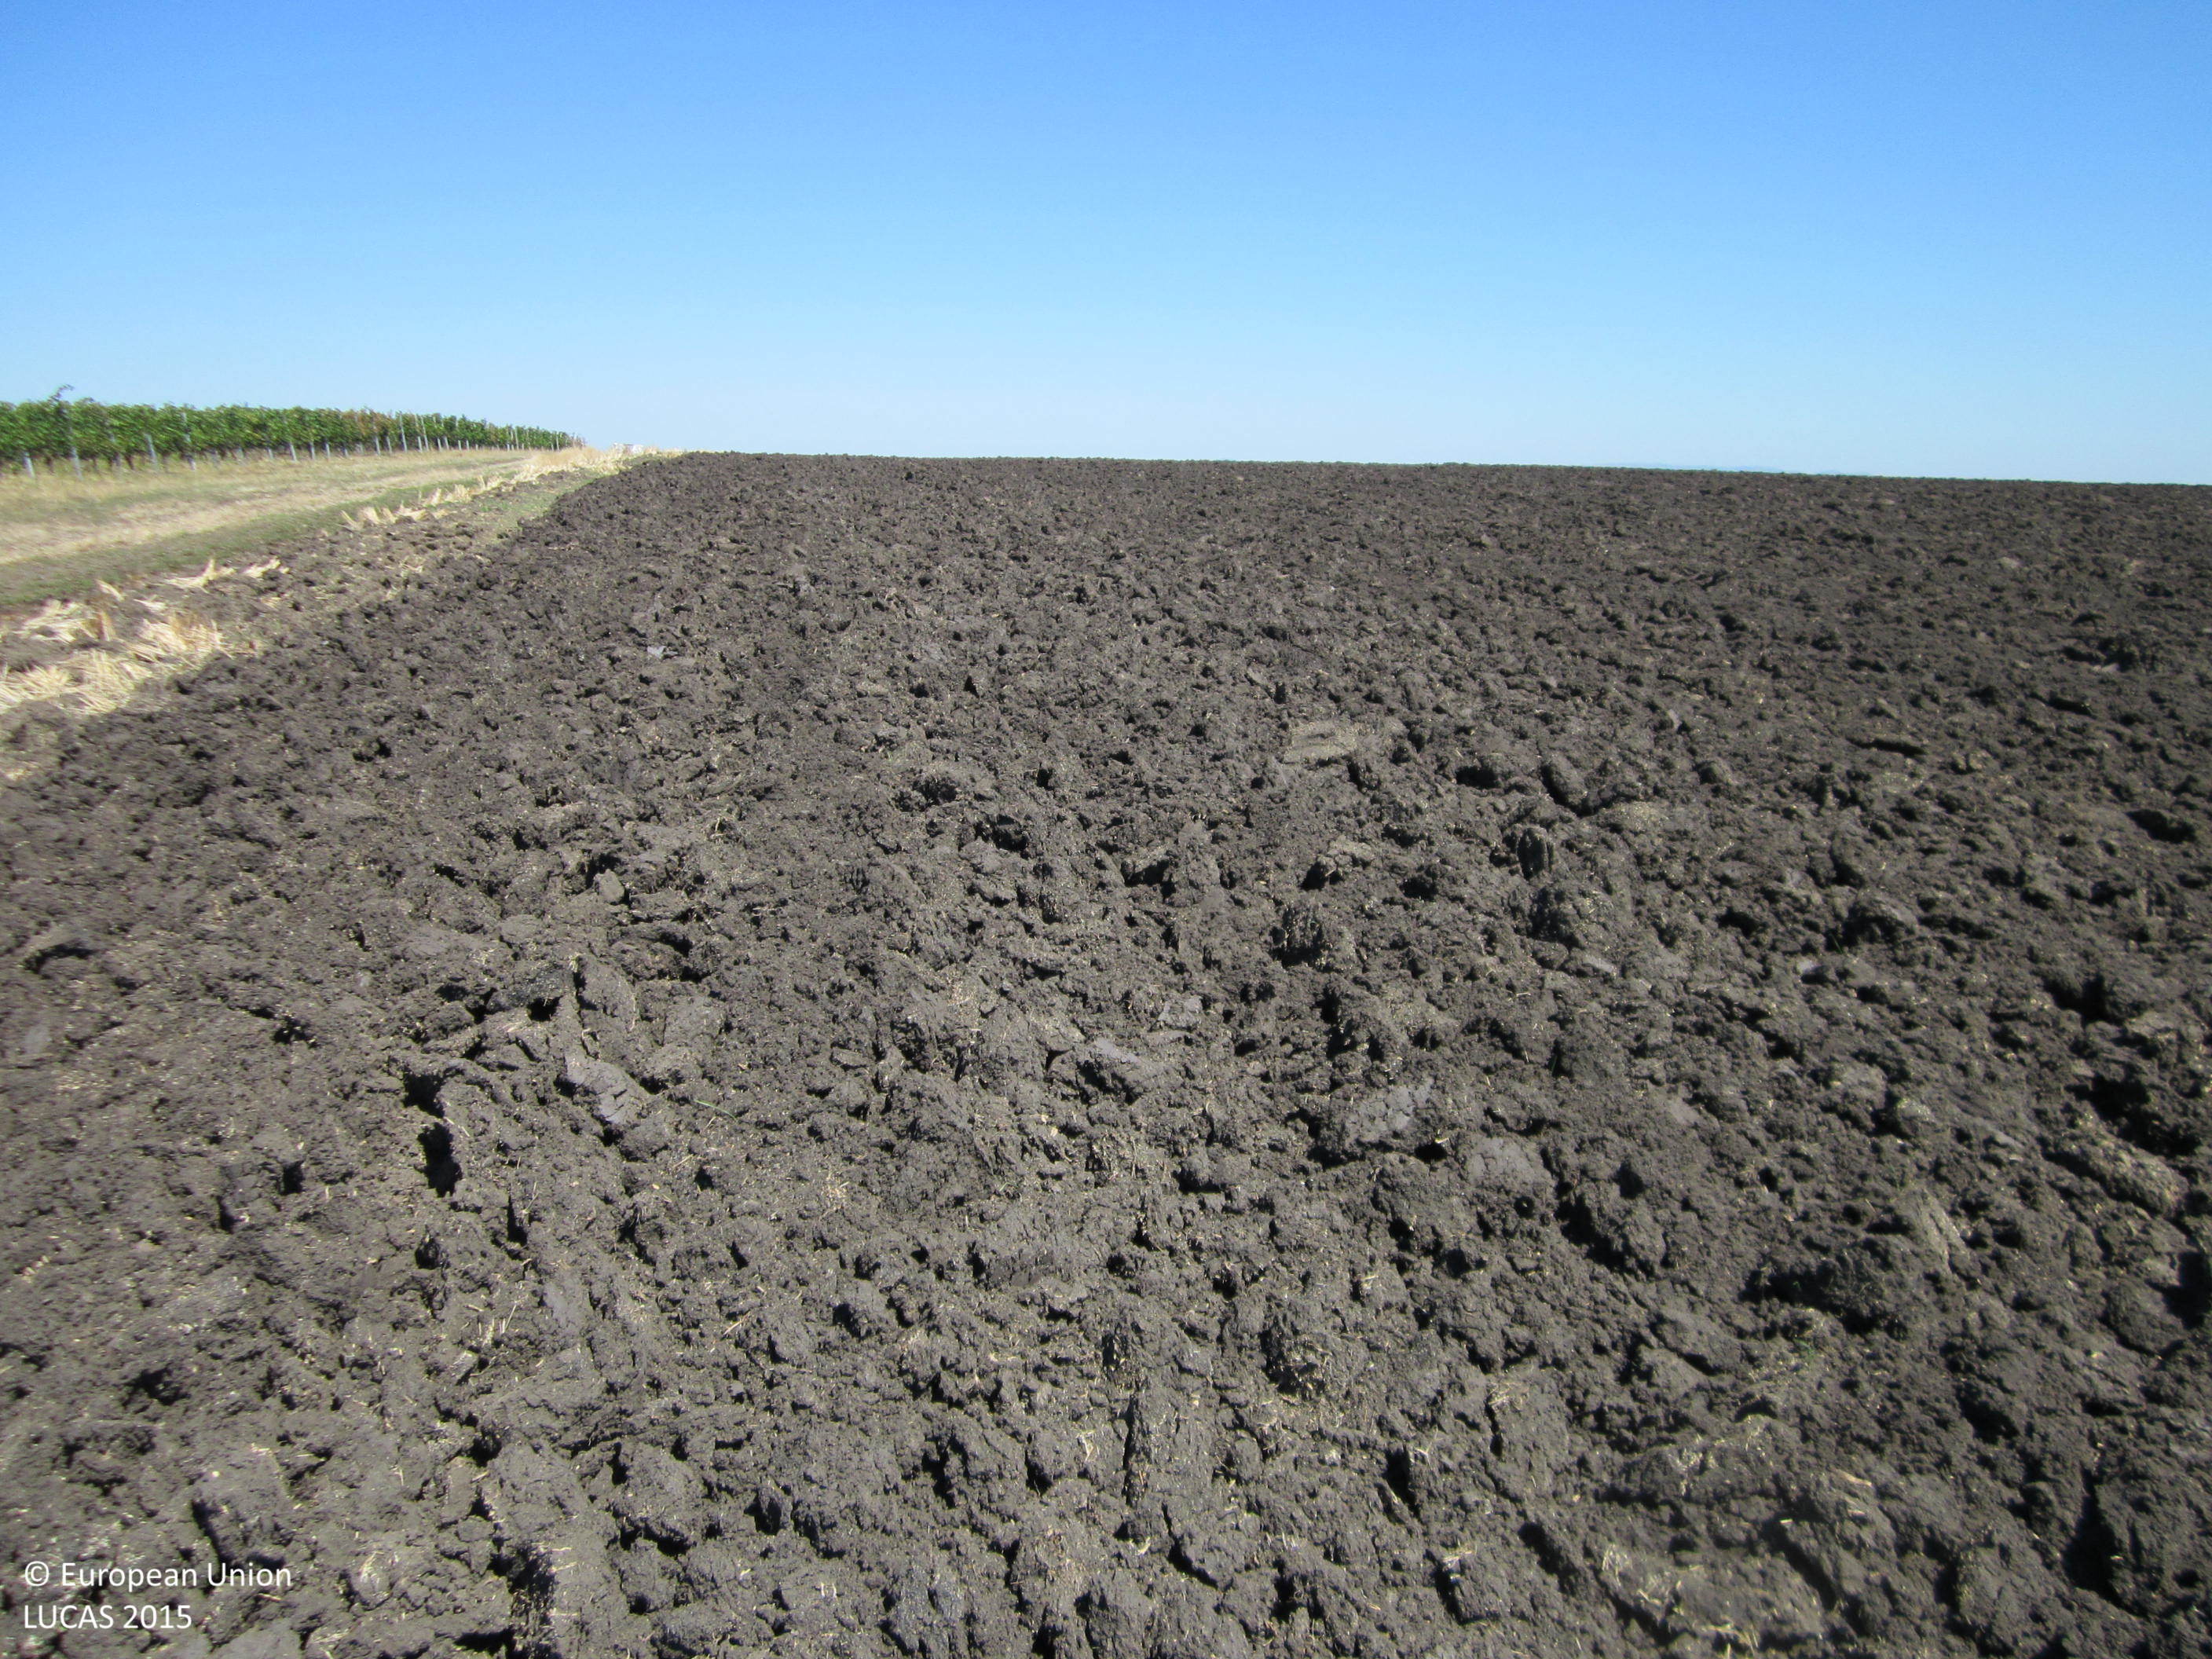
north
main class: Cropland
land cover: Common wheat
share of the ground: < 10 %
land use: Agriculture (excluding fallow land and kitchen gardens)
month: September
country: BG
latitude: 42.5331
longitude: 27.0915
